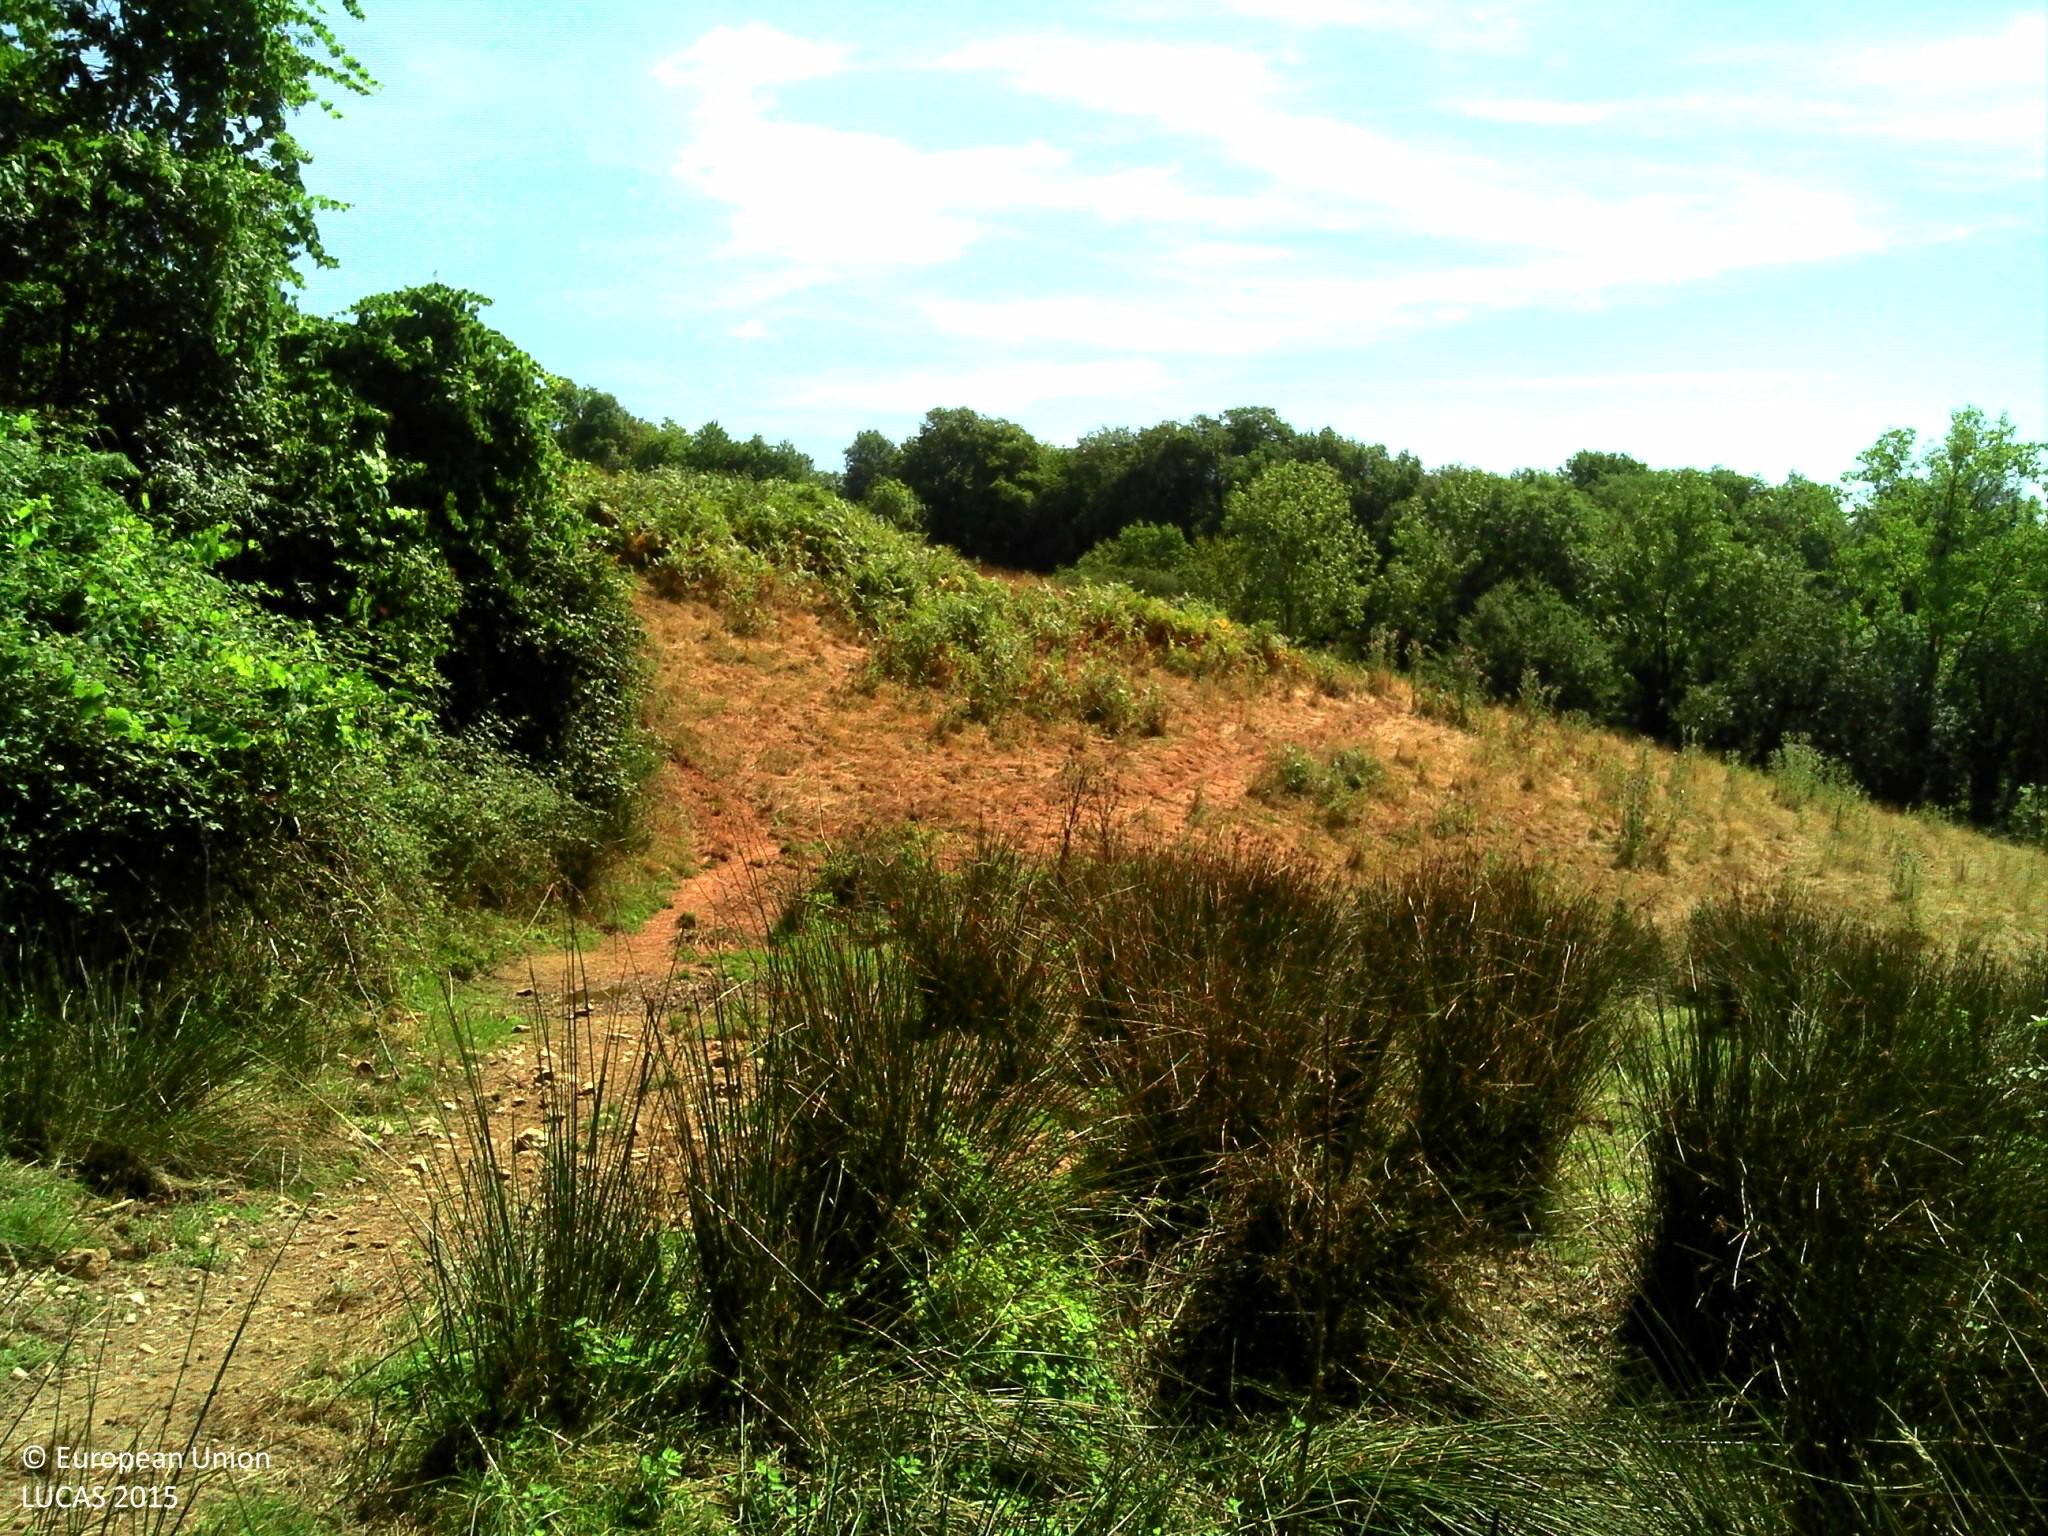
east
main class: Grassland
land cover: Grassland without tree/shrub cover
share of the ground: > 75 %
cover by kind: herbaceous plants 100 %
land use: Agriculture (excluding fallow land and kitchen gardens)
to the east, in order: Grassland without tree/shrub cover; Spontaneously vegetated surfaces; Grassland without tree/shrub cover; Spontaneously vegetated surfaces; Fences; Broadleaved woodland; Fences; Grassland without tree/shrub cover
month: August
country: FR
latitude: 43.9784
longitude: 2.6126
